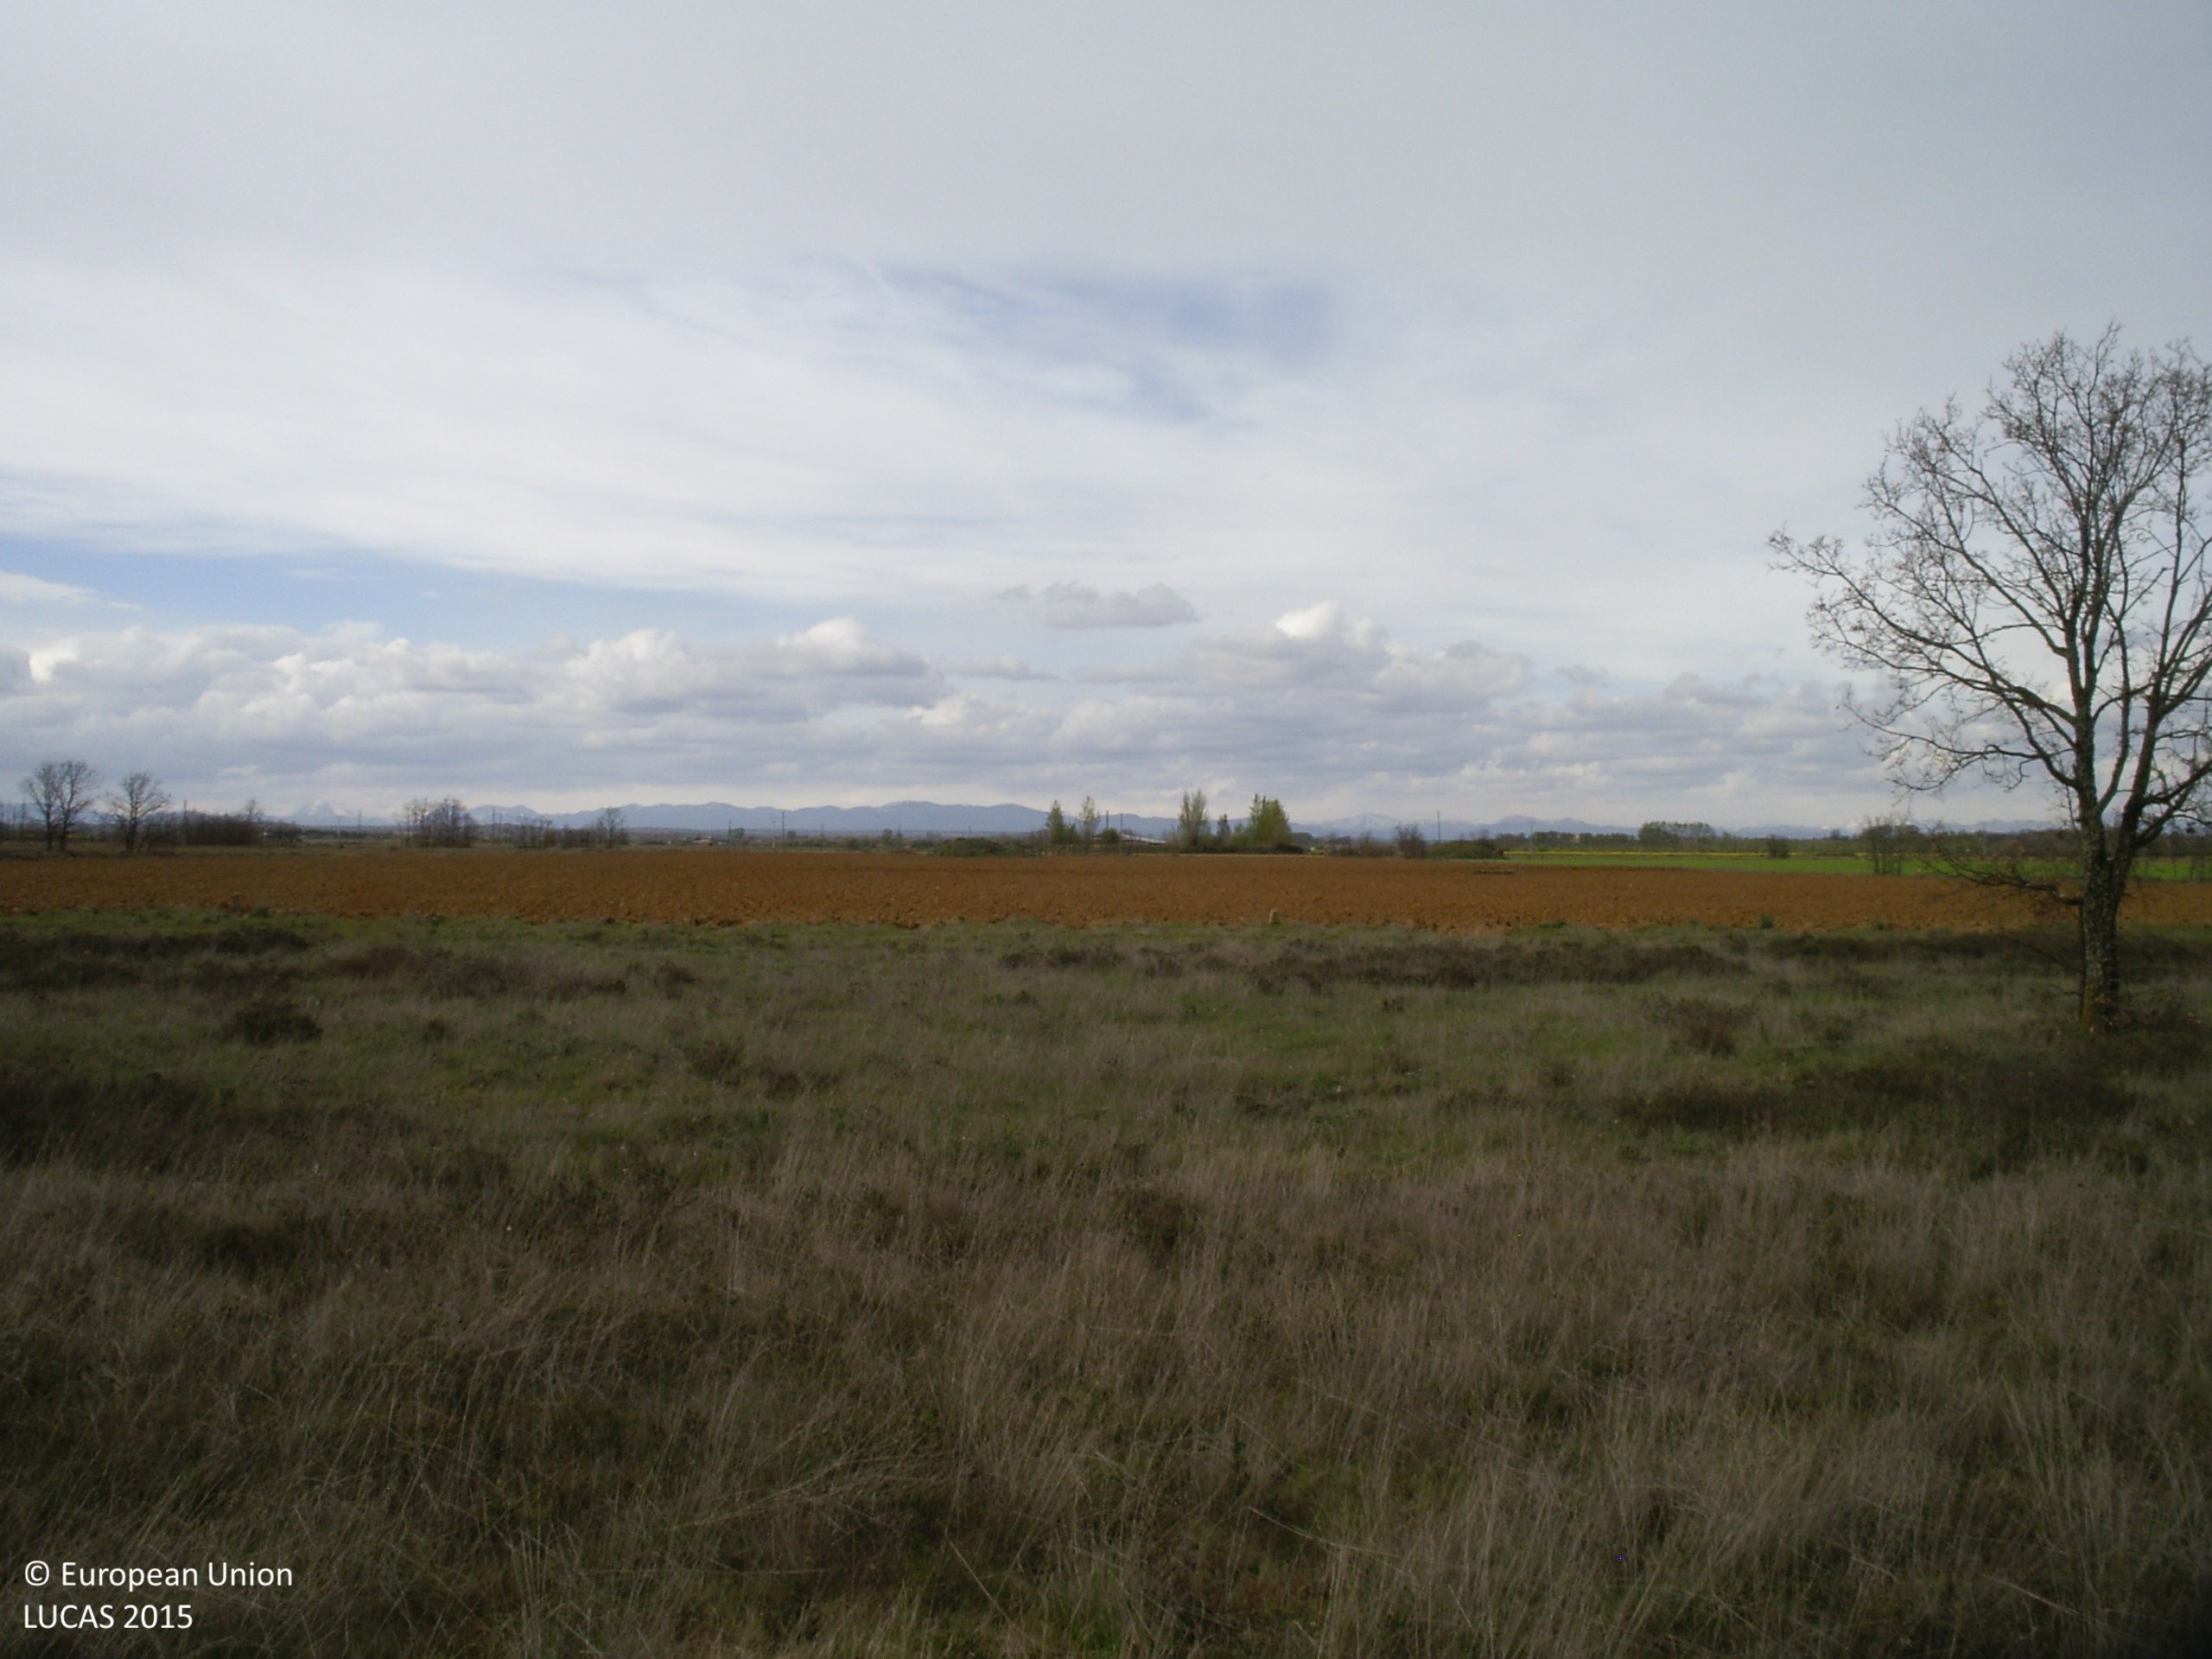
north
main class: Grassland
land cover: Grassland with sparse tree/shrub cover
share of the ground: > 75 %
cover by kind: herbaceous plants 95 %, coniferous forest trees 5 %
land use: Abandoned areas
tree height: < 5 m
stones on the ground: < 10 %
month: April
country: ES
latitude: 42.5023
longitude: -5.7117
